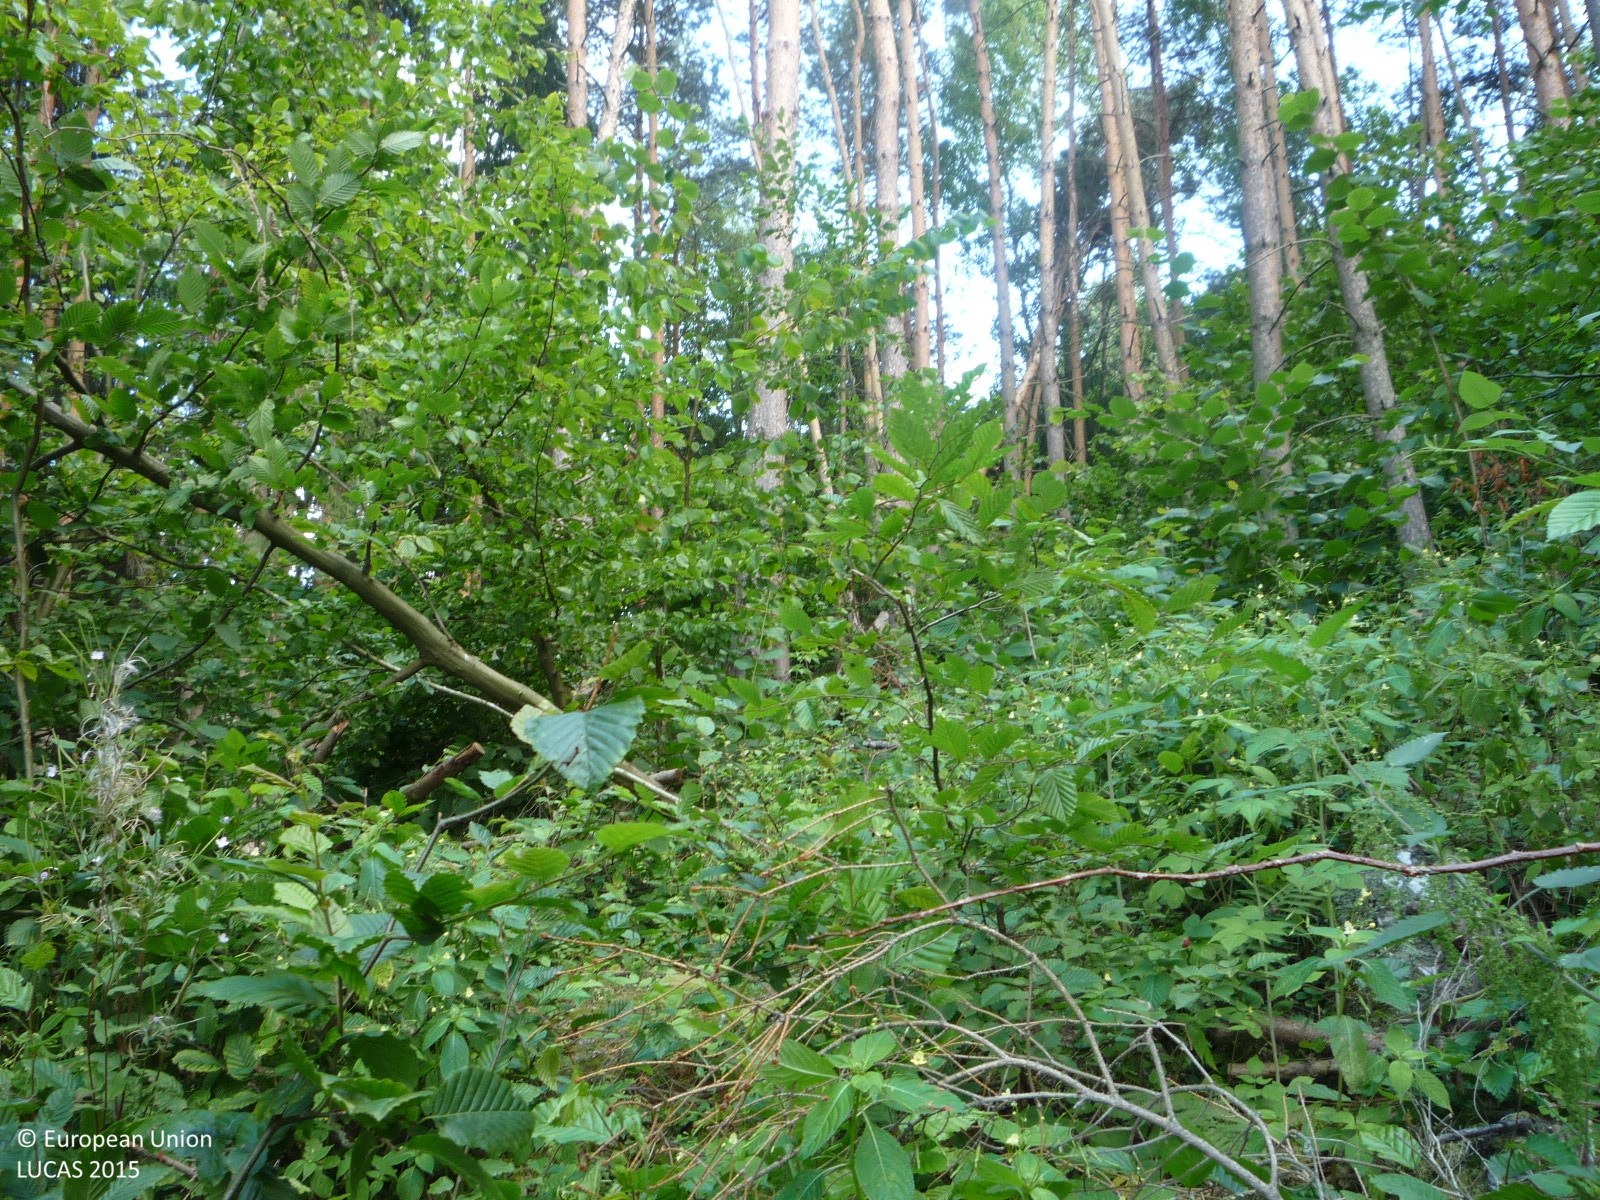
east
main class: Woodland
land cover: Other mixed woodland
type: hemiboreal forest and nemoral coniferous forest and mixed broadleaved-coniferous forest
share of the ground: > 75 %
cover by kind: coniferous forest trees 50 %, broadleaved forest trees 30 %, herbaceous plants 20 %
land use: Forestry
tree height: > 5 m
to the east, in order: Other mixed woodland; Spruce dominated mixed woodland; Spontaneously vegetated surfaces; Broadleaved woodland; Fences; Grassland without tree/shrub cover; Fences; Broadleaved woodland; Spontaneously vegetated surfaces; Other coniferous woodland; Pine dominated coniferous woodland; Rock outcrops; Pine dominated mixed woodland
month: July
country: CZ
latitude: 50.5456
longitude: 14.5035
